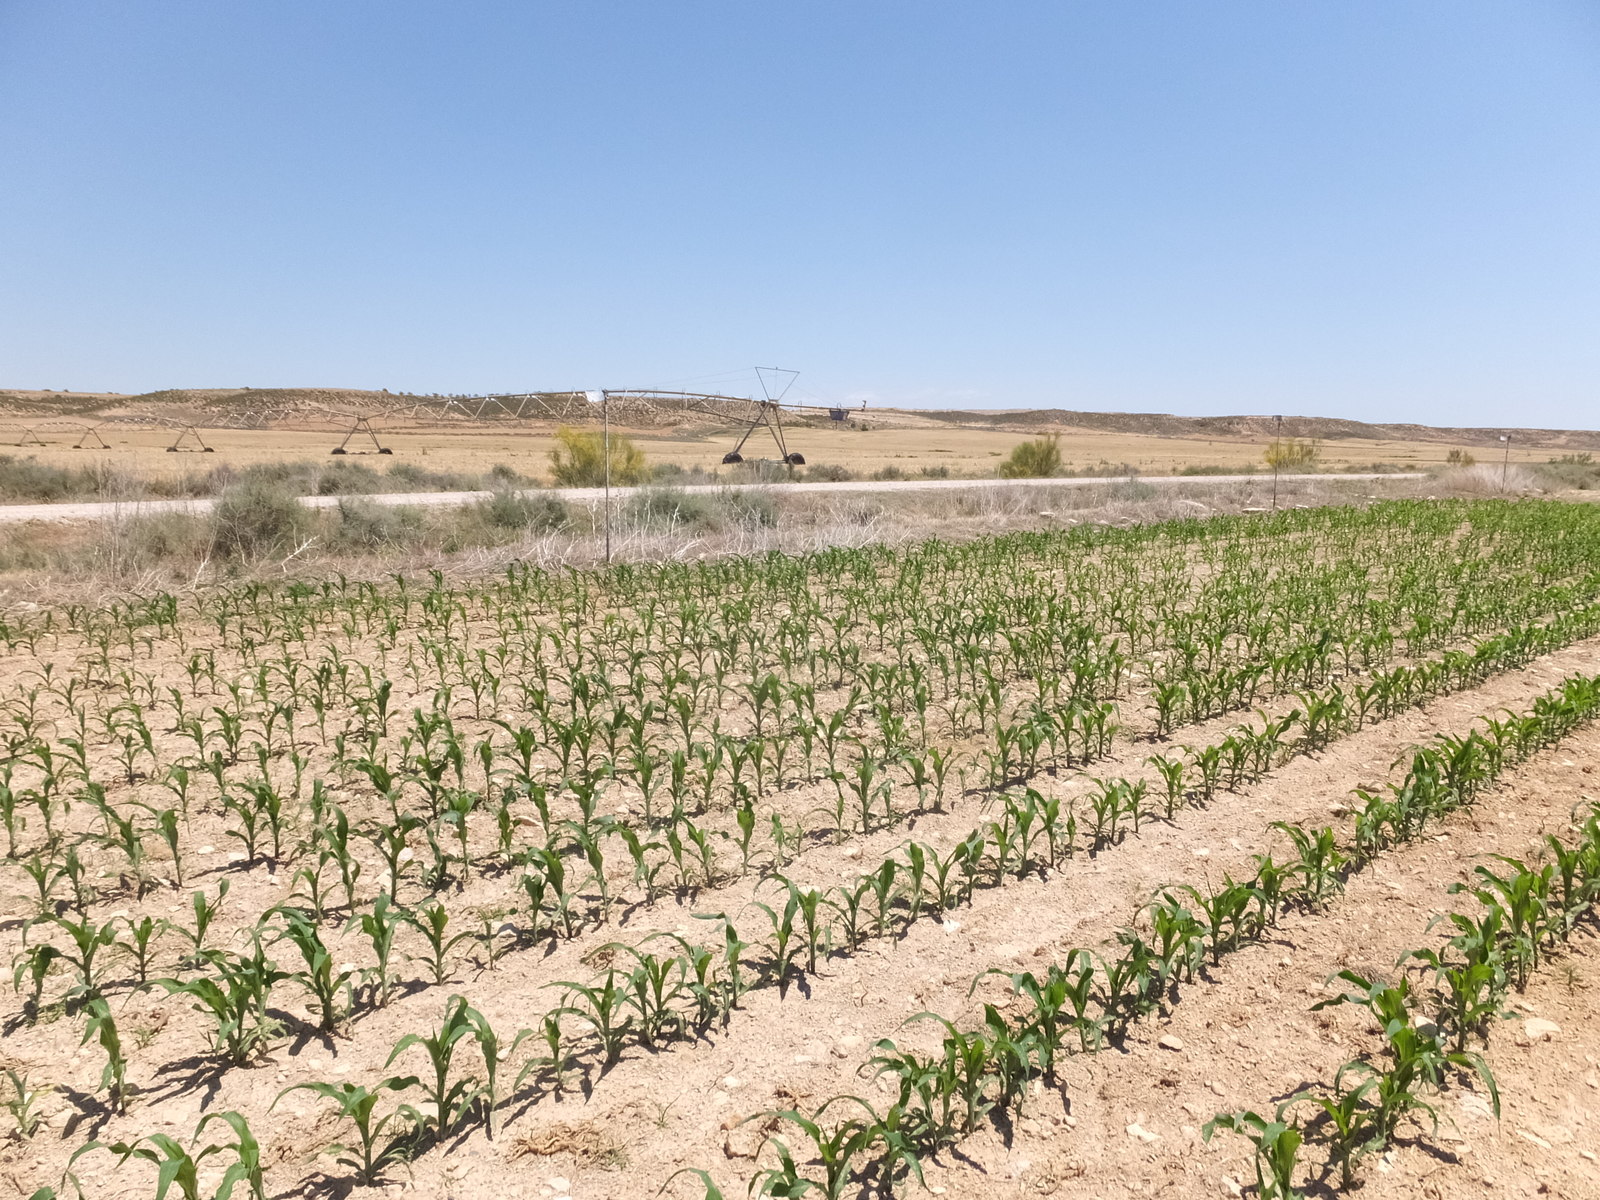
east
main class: Cropland
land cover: Maize
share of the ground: < 10 %
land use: Agriculture (excluding fallow land and kitchen gardens)
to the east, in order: Maize; Grass margins; Tracks; Shruby margins; Barley; Grass margins; Barley
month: June
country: ES
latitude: 41.5288
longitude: 0.0742
